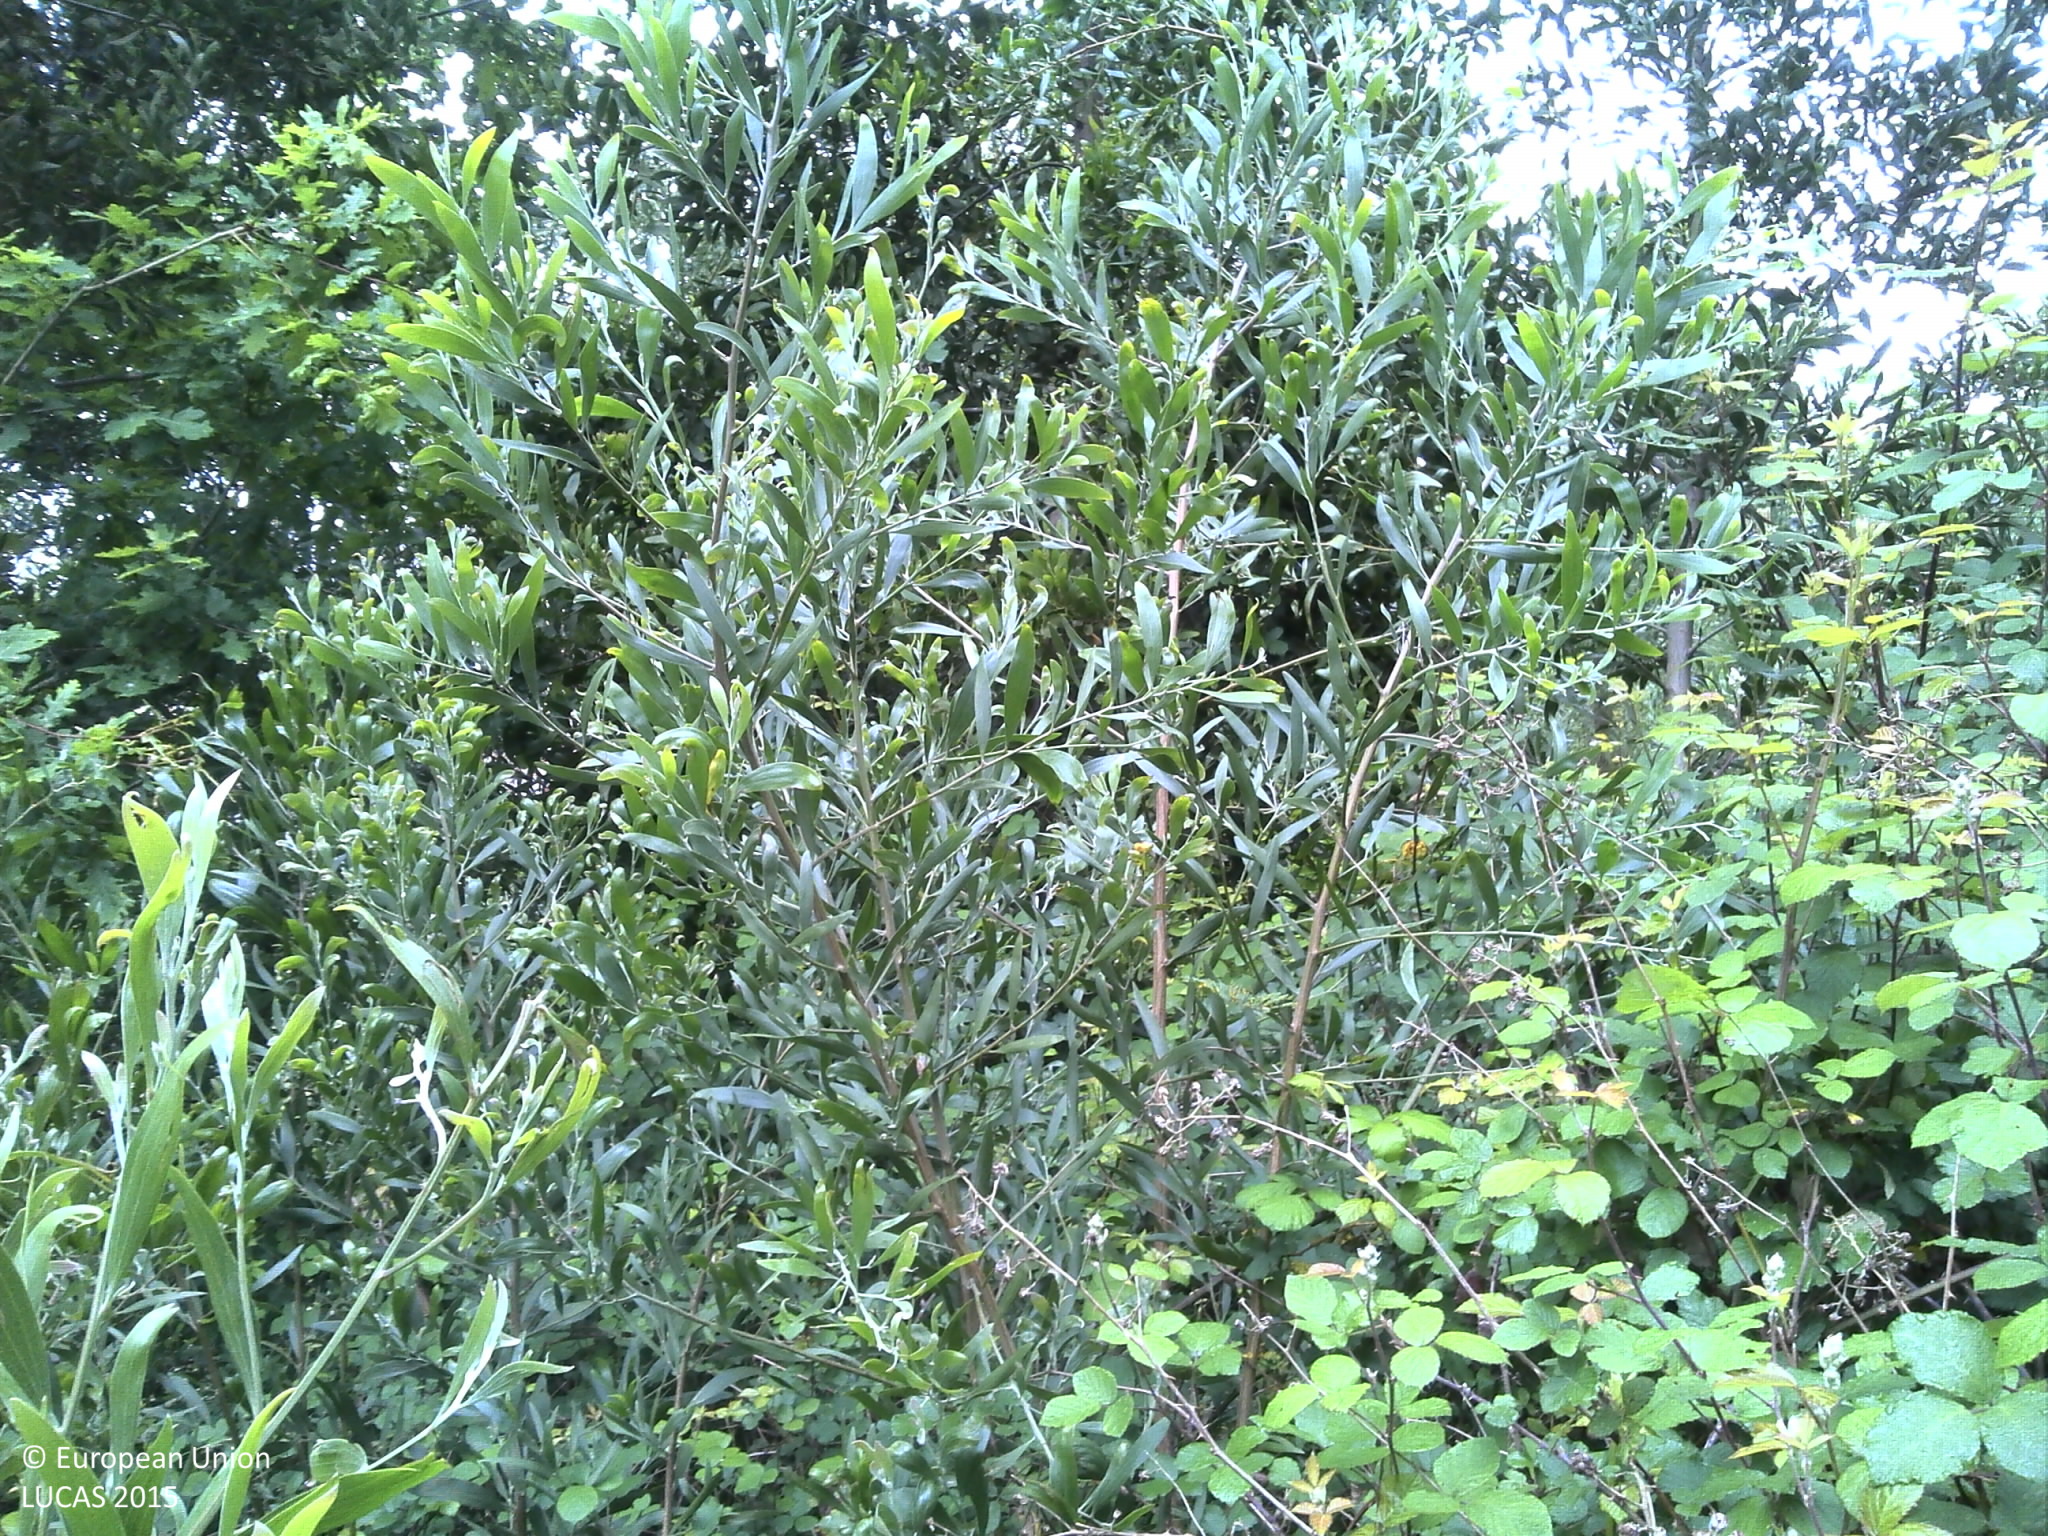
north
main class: Woodland
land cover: Broadleaved woodland
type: exotic forest
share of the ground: 10 - 25 %
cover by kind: shrubs 75 %, broadleaved forest trees 15 %, herbaceous plants 10 %
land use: Forestry
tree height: > 5 m
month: May
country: PT
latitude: 40.8413
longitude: -8.4913
